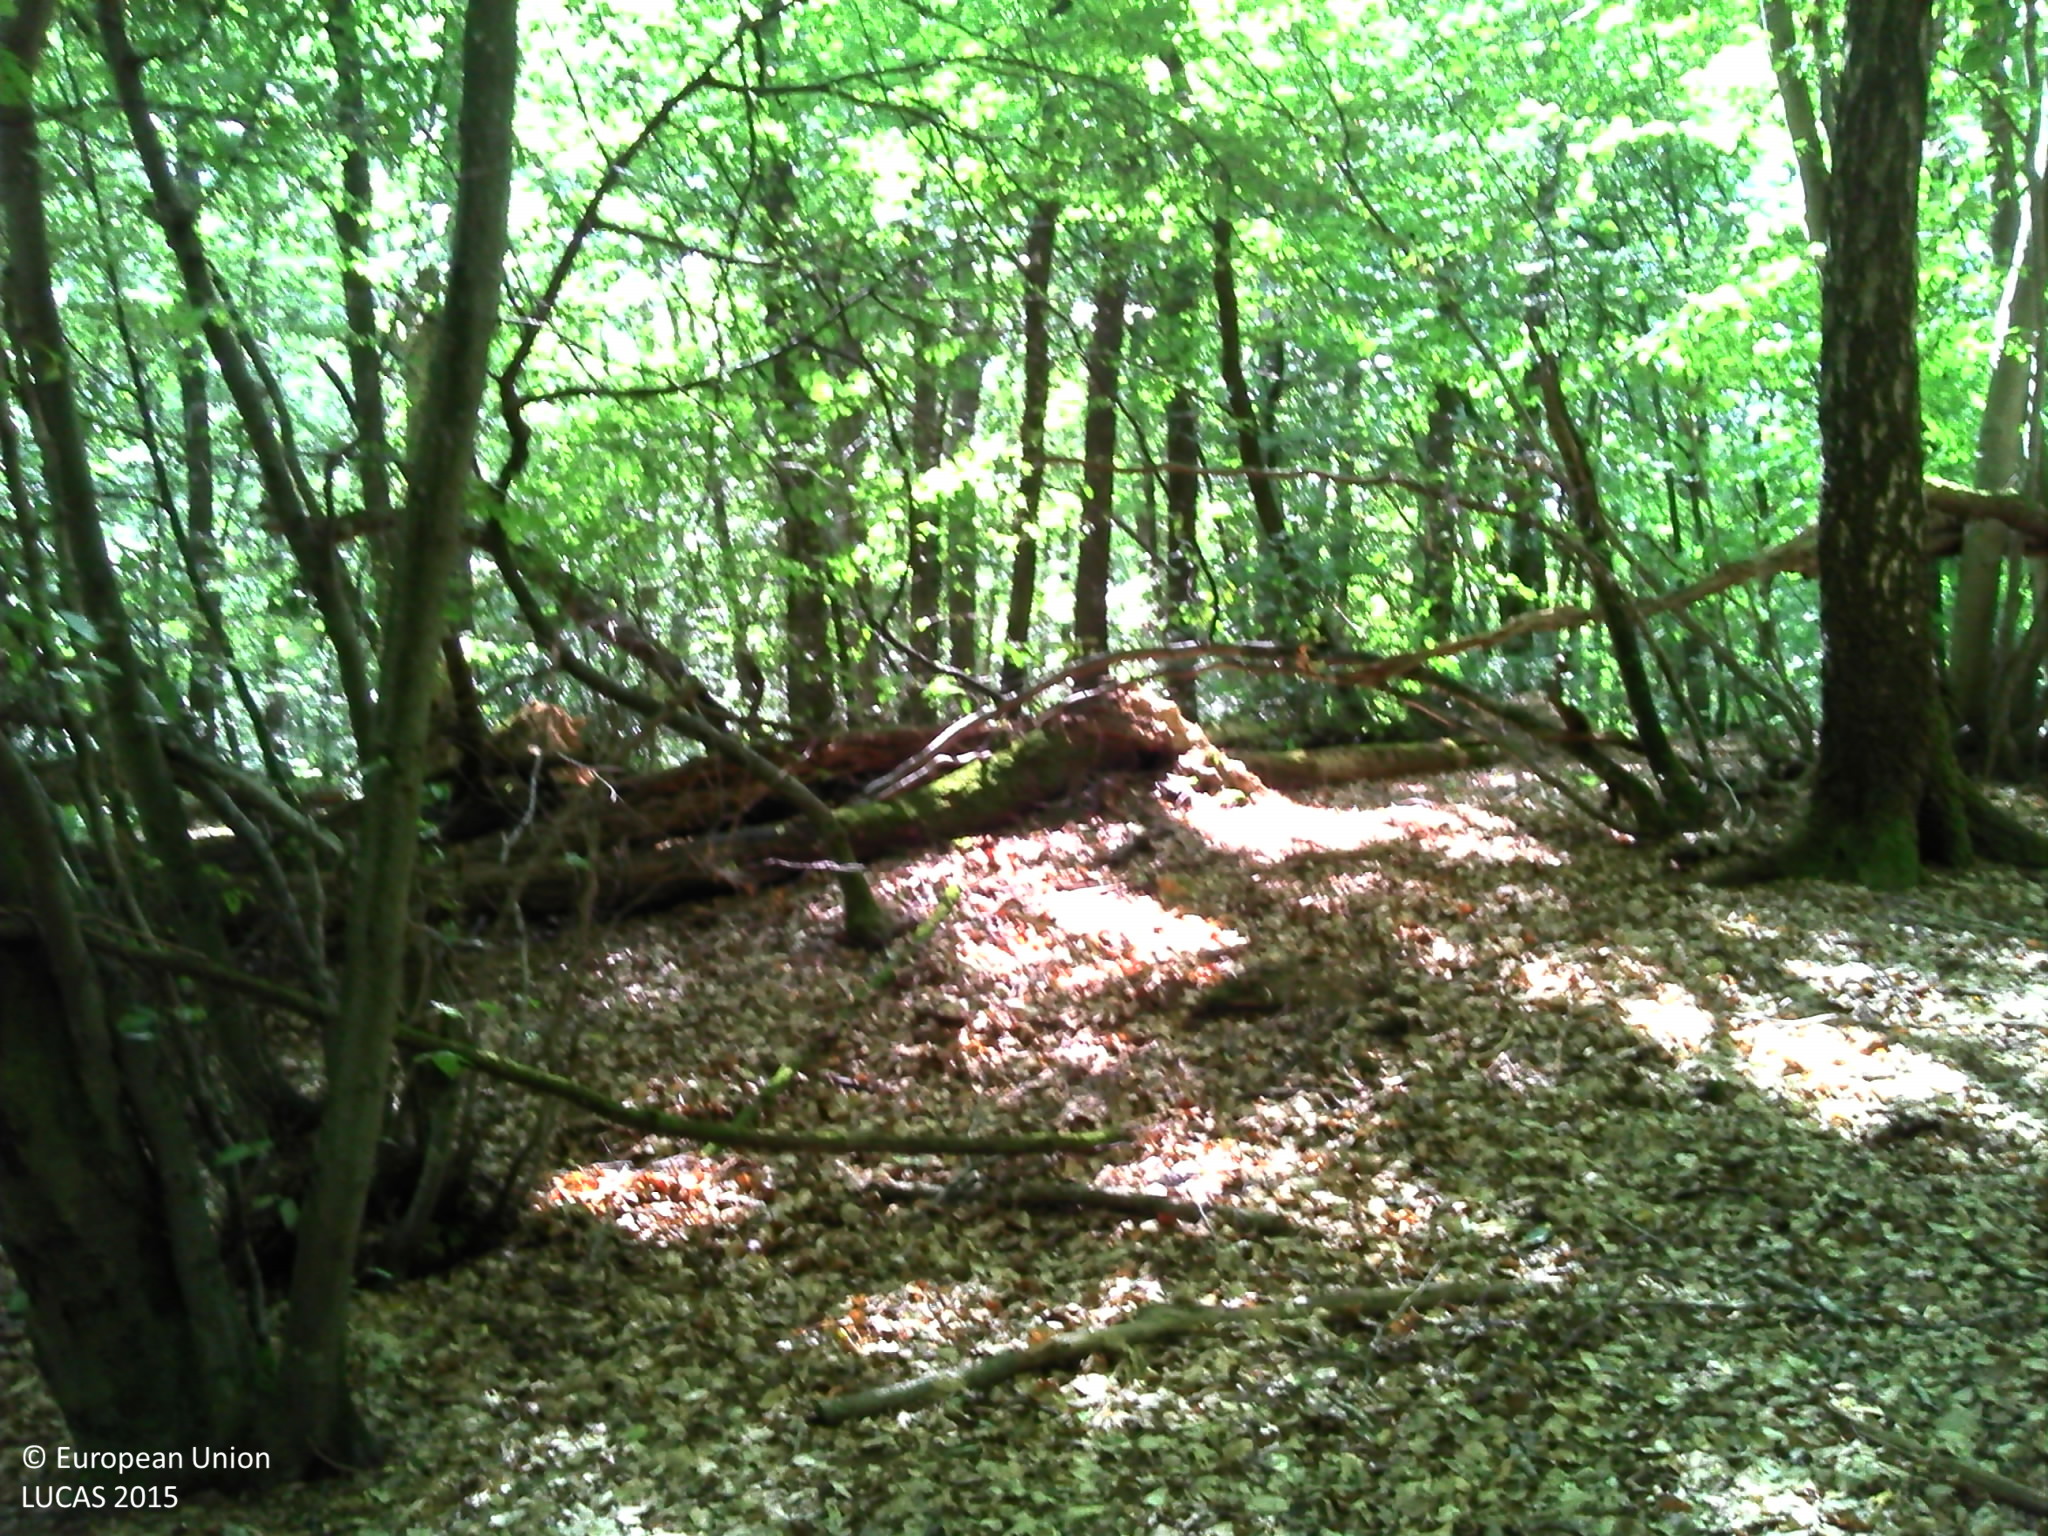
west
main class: Woodland
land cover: Broadleaved woodland
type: acidophilous oak and oak-birch forest
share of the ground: > 75 %
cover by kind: broadleaved forest trees 40 %, herbaceous plants 25 %, unconsolidated bare surface 20 %, coniferous forest trees 5 %, lichens and mosses 5 %
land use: Forestry
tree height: > 5 m
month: August
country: FR
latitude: 49.1307
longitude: 4.1160
